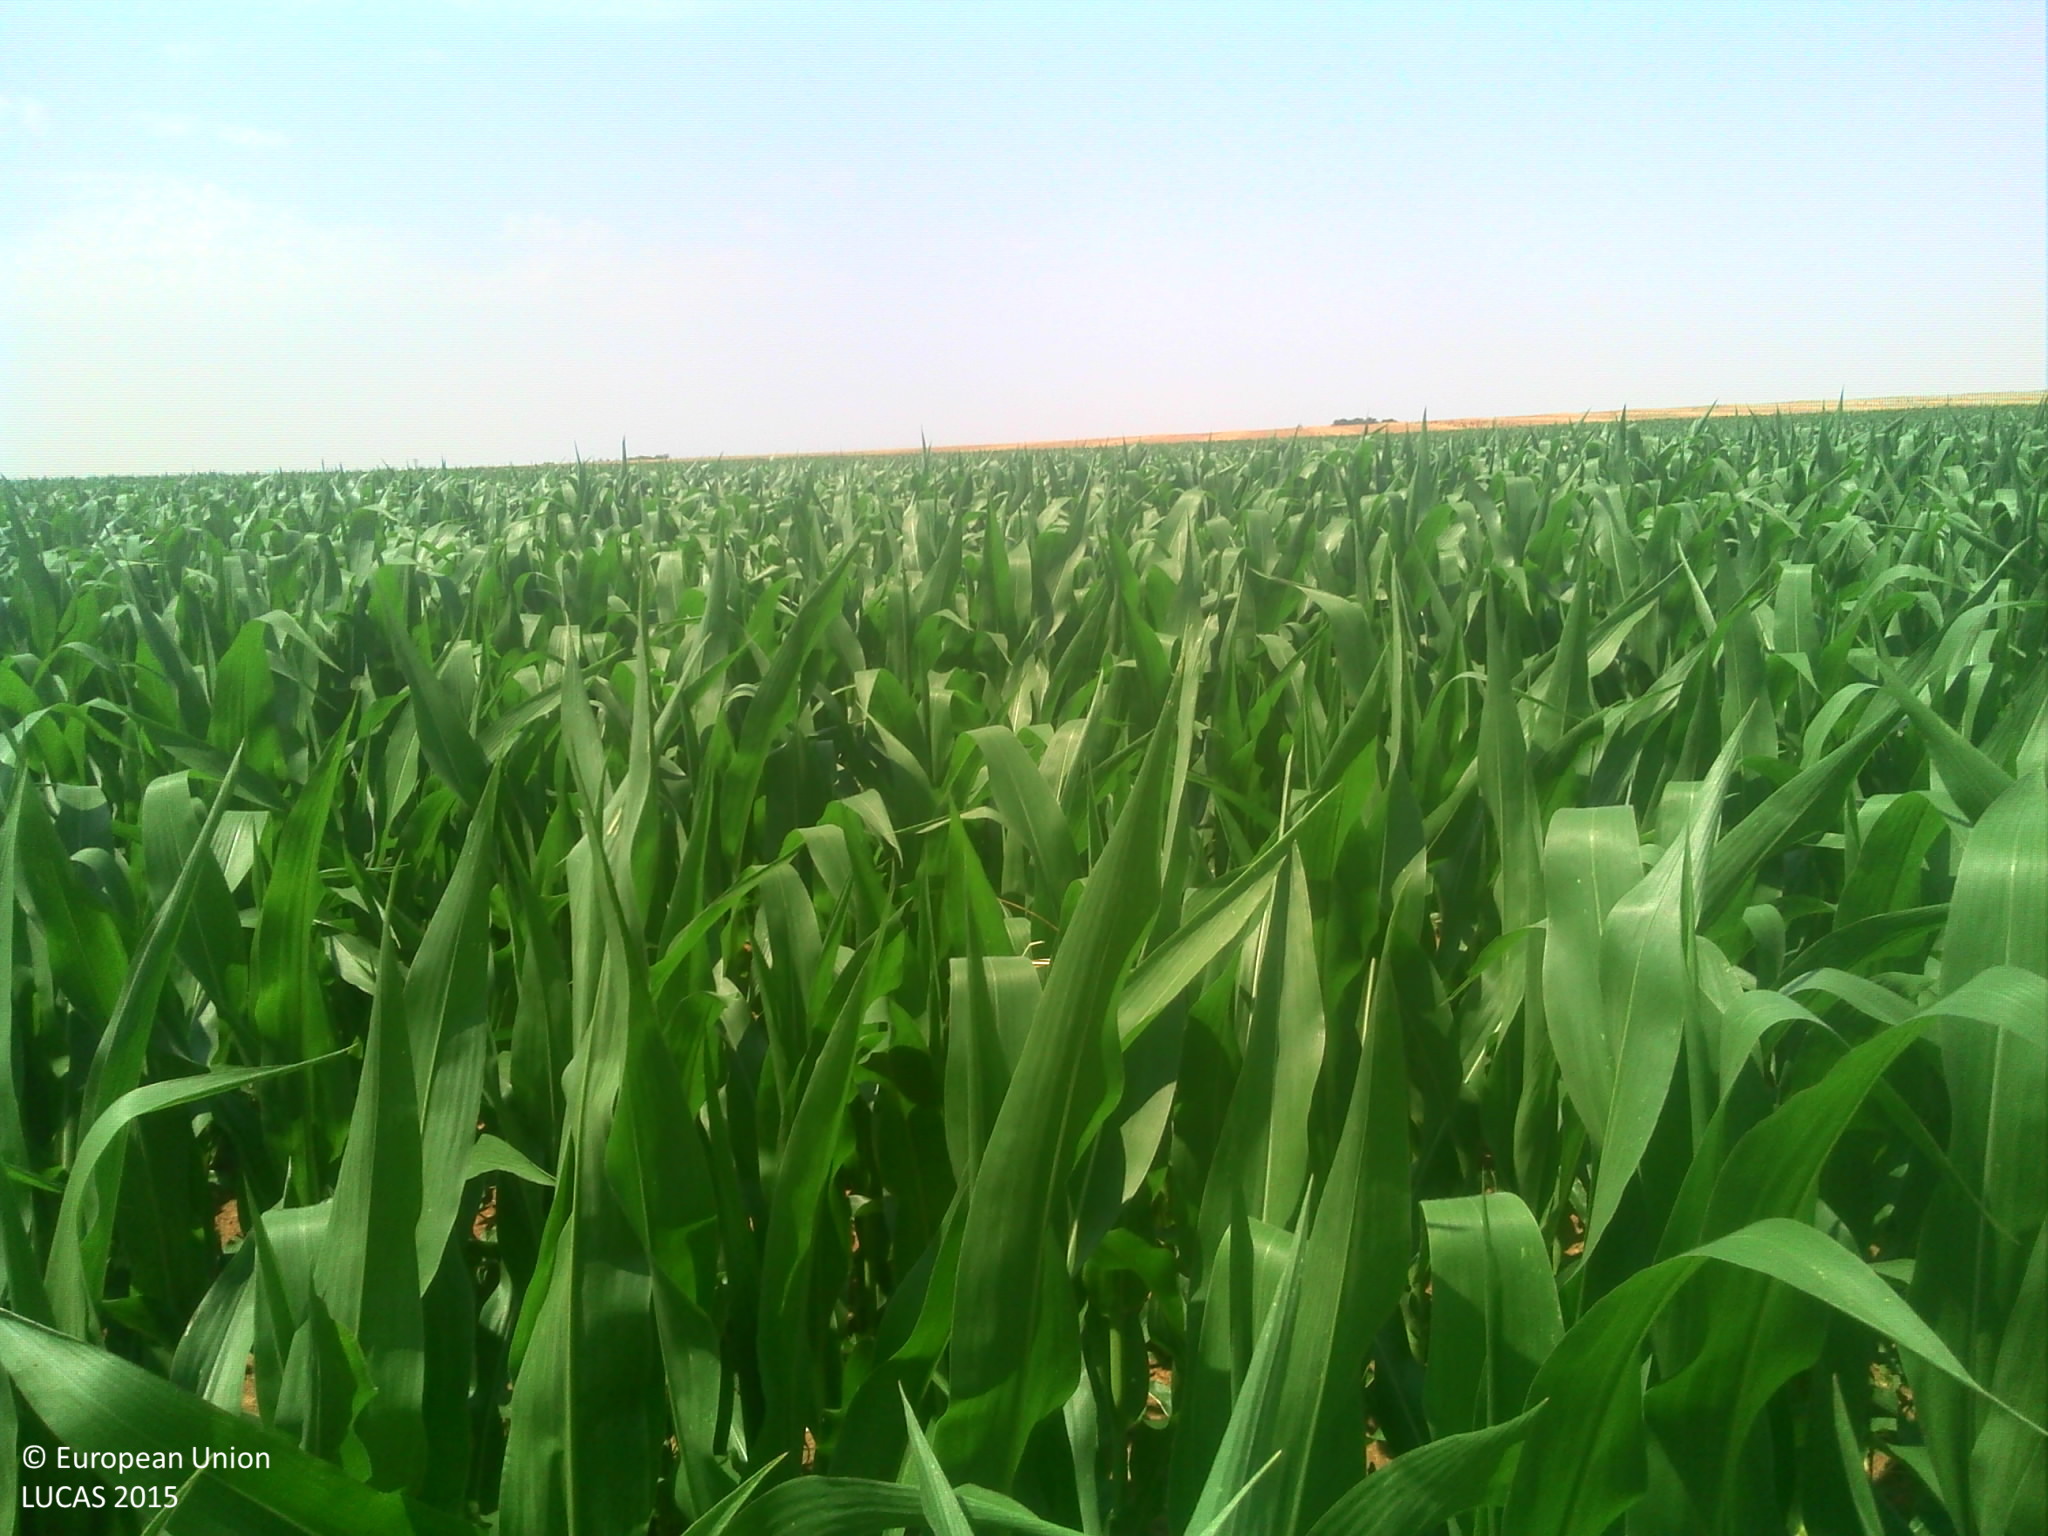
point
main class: Cropland
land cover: Maize
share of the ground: > 75 %
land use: Agriculture (excluding fallow land and kitchen gardens)
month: July
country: FR
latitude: 47.6673
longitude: 1.3683
